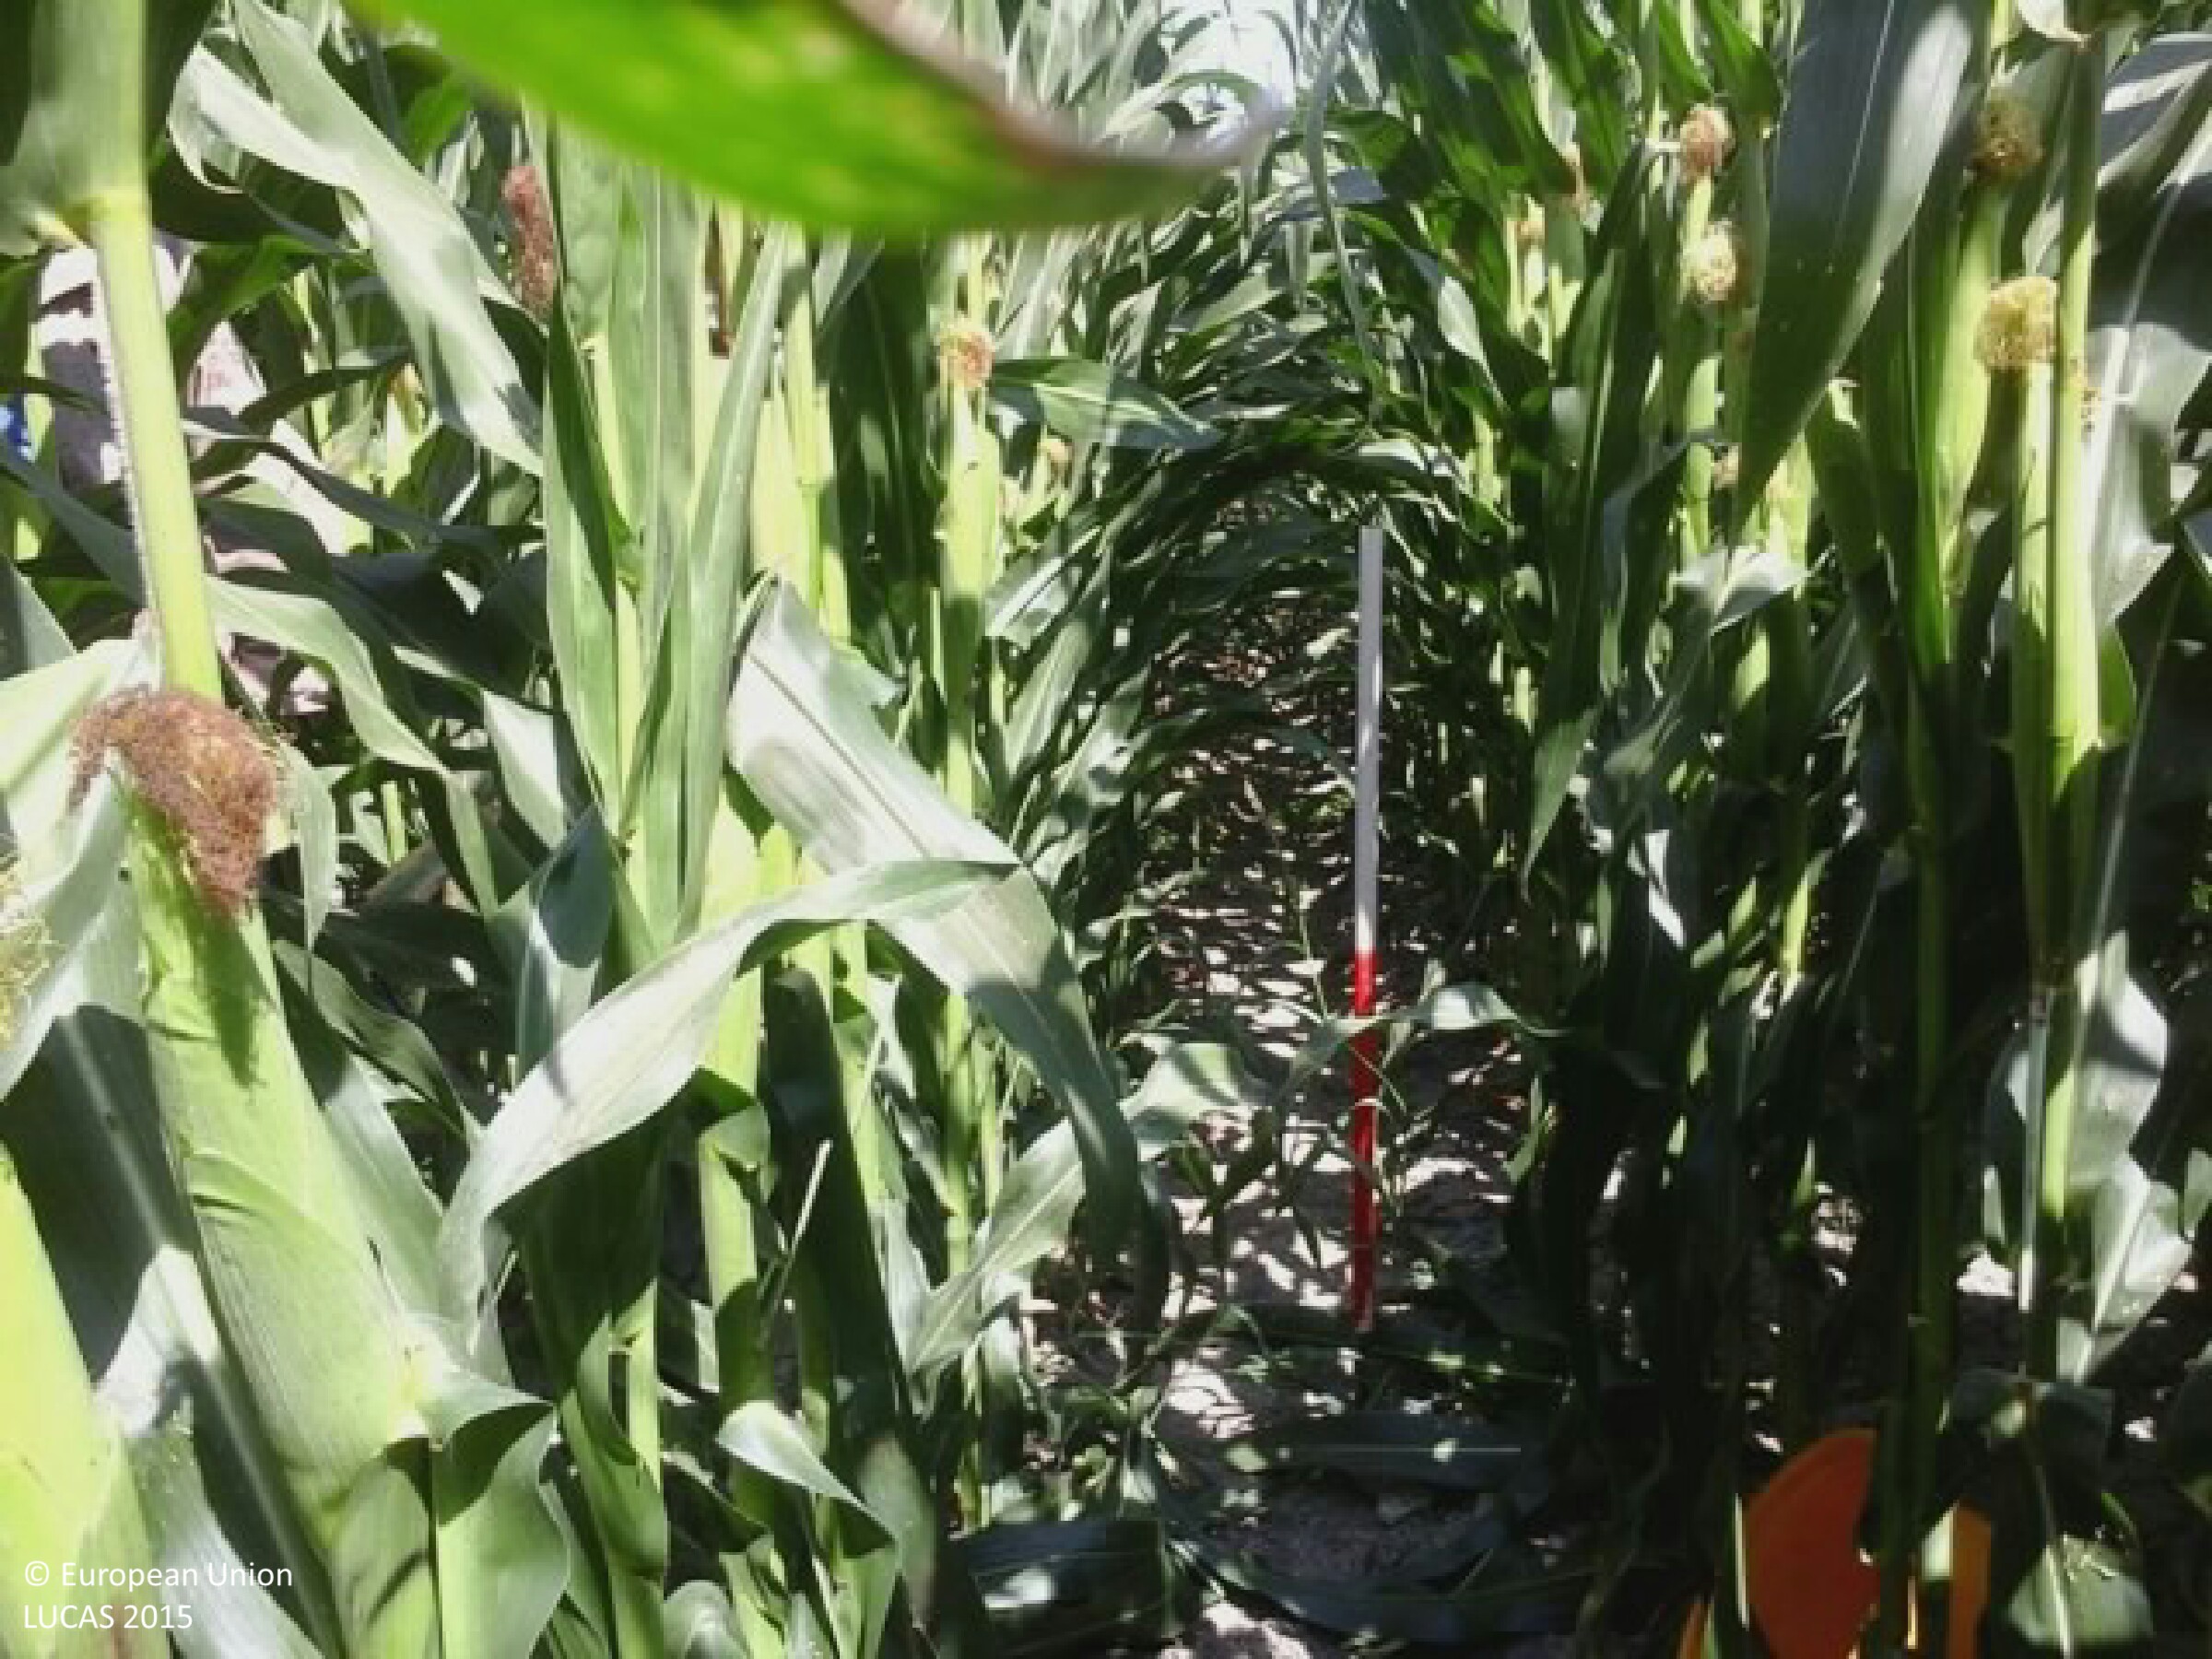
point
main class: Cropland
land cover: Maize
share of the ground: > 75 %
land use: Agriculture (excluding fallow land and kitchen gardens)
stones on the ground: < 10 %
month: July
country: HU
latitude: 46.4703
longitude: 18.8815
